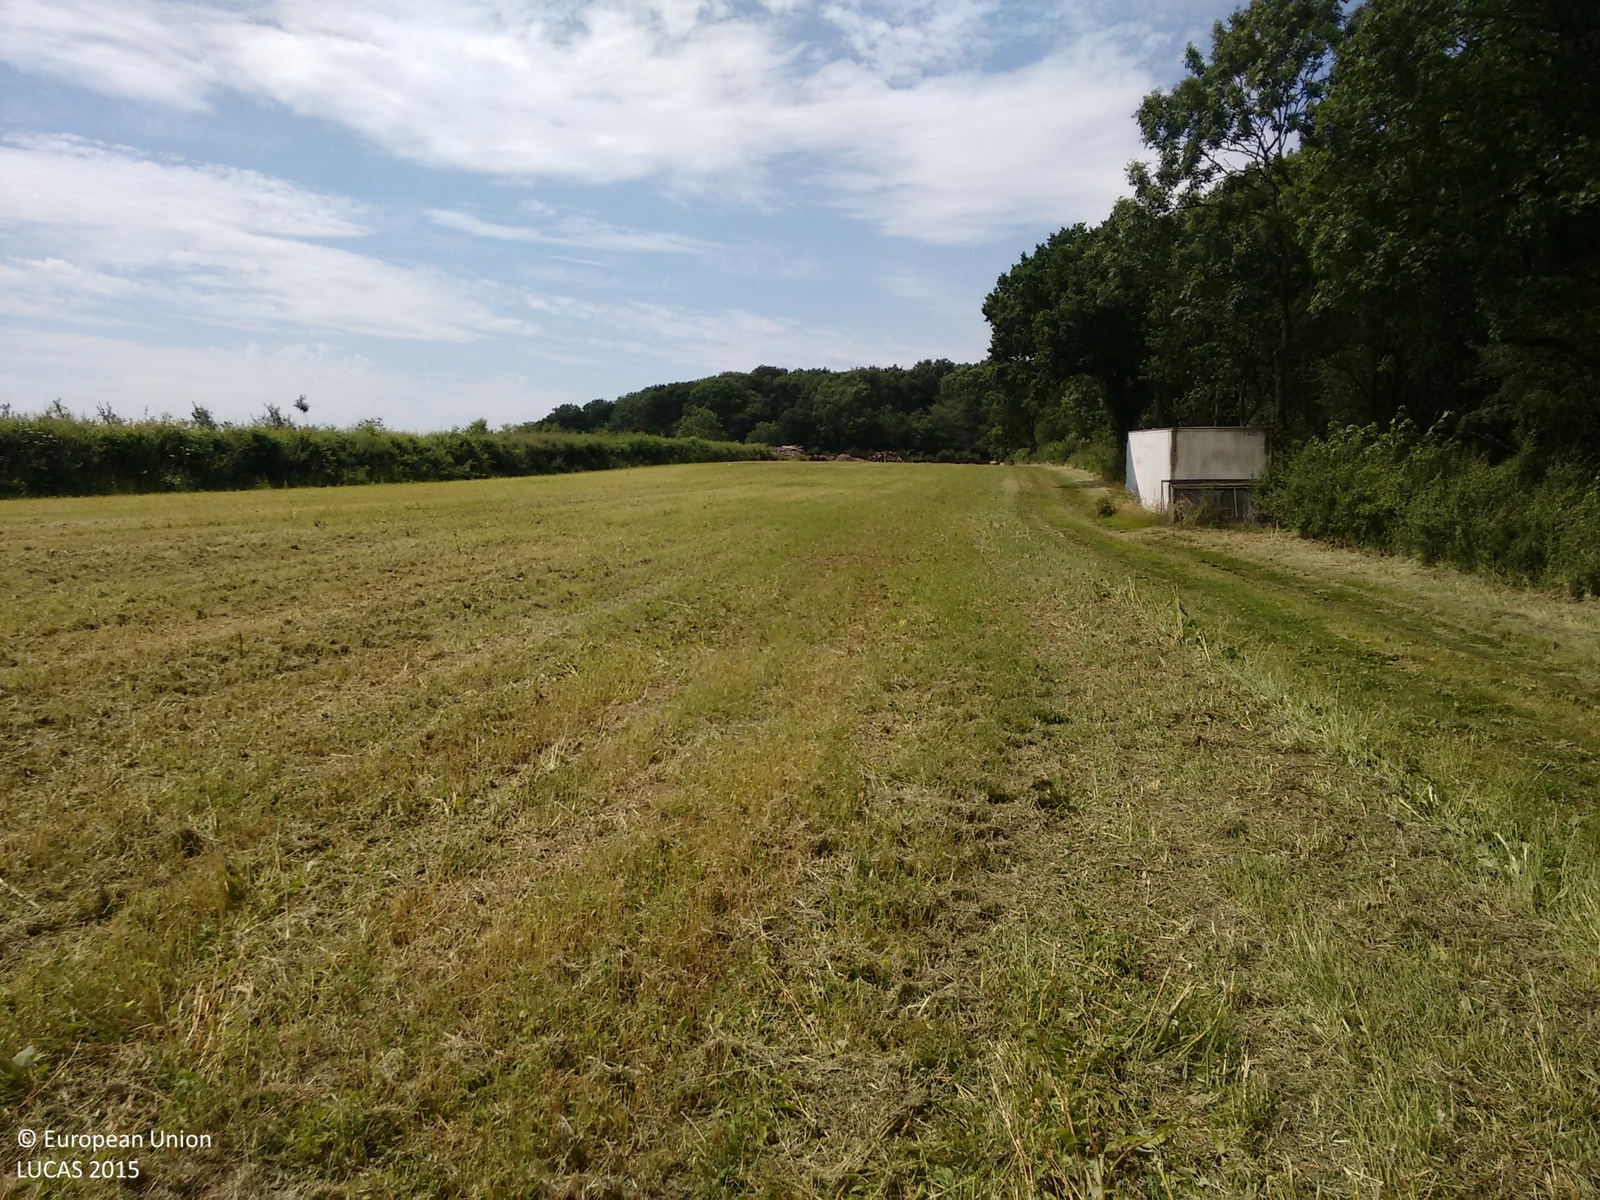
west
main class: Grassland
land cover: Grassland without tree/shrub cover
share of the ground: > 75 %
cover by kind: herbaceous plants 100 %
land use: Agriculture (excluding fallow land and kitchen gardens)
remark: Harvested field
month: July
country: GB
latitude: 53.3287
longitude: -0.8676
